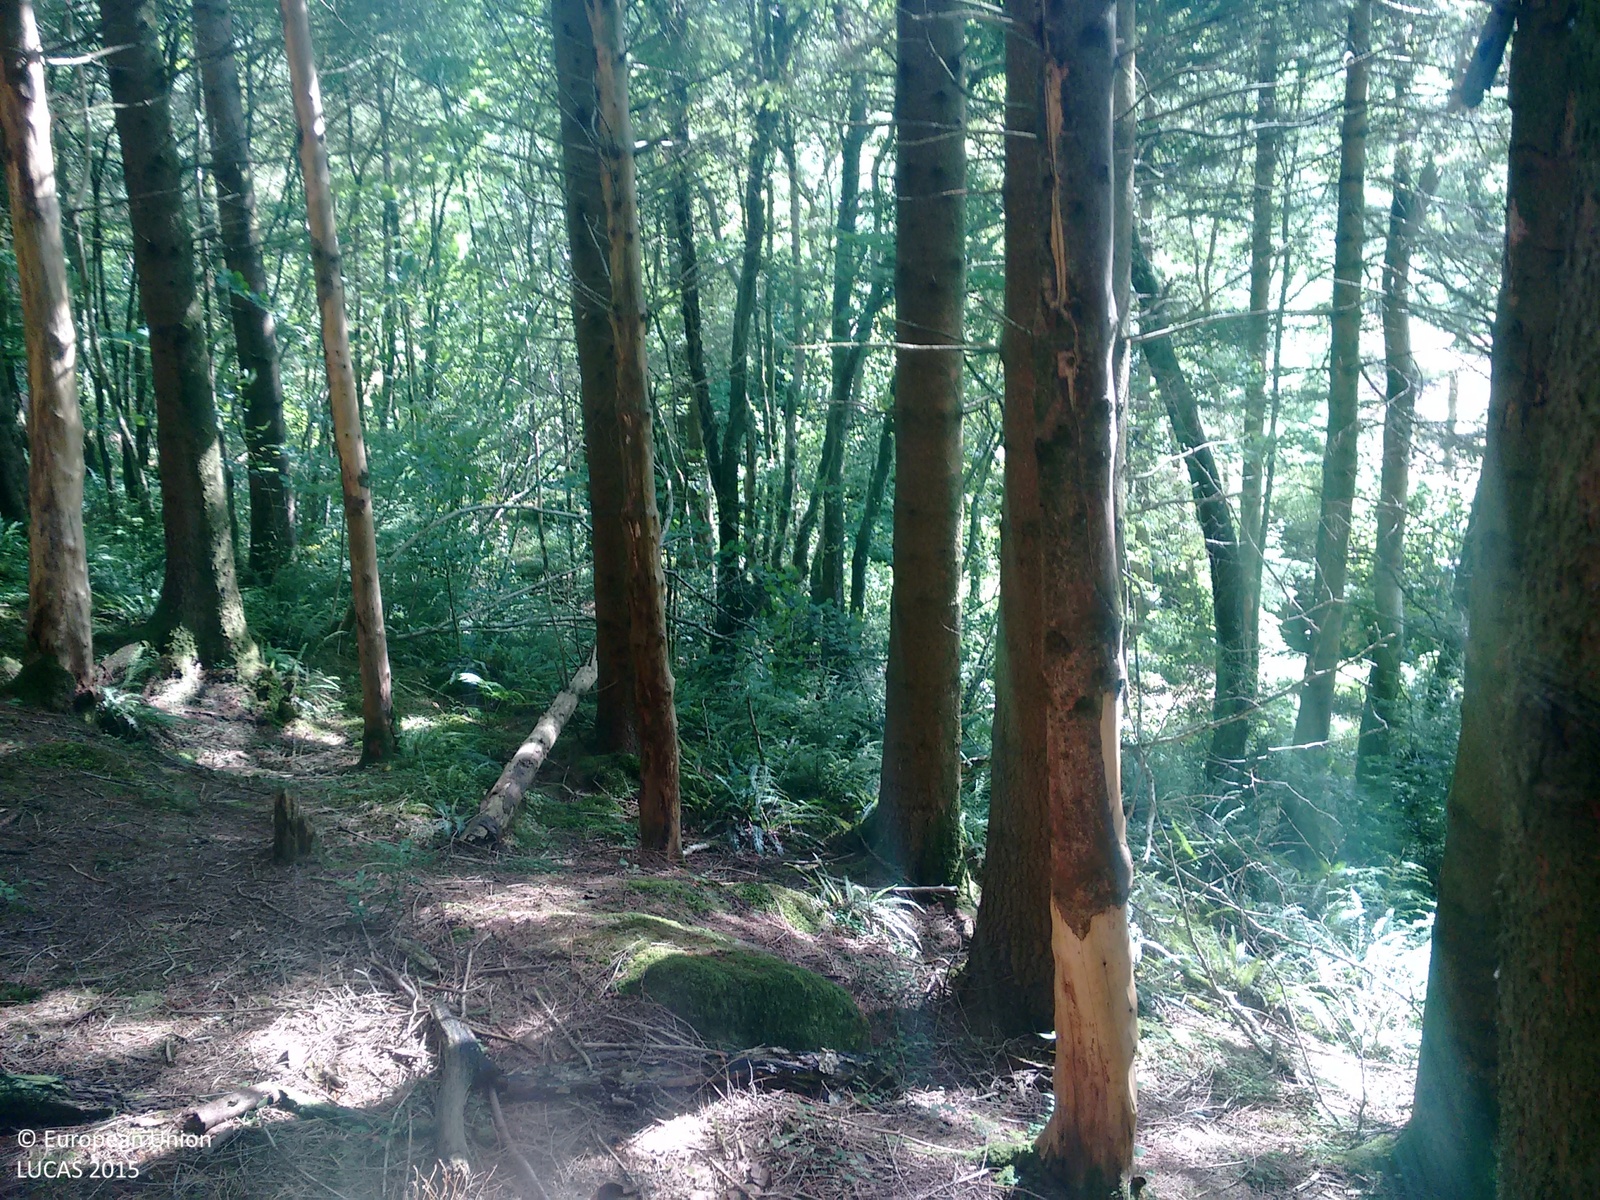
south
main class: Woodland
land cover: Pine dominated coniferous woodland
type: exotic forest
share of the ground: > 75 %
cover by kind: coniferous forest trees 90 %, broadleaved forest trees 10 %
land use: Forestry
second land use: Amenities, museums, leisure
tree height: > 5 m
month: July
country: GB
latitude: 55.5194
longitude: -5.1460
